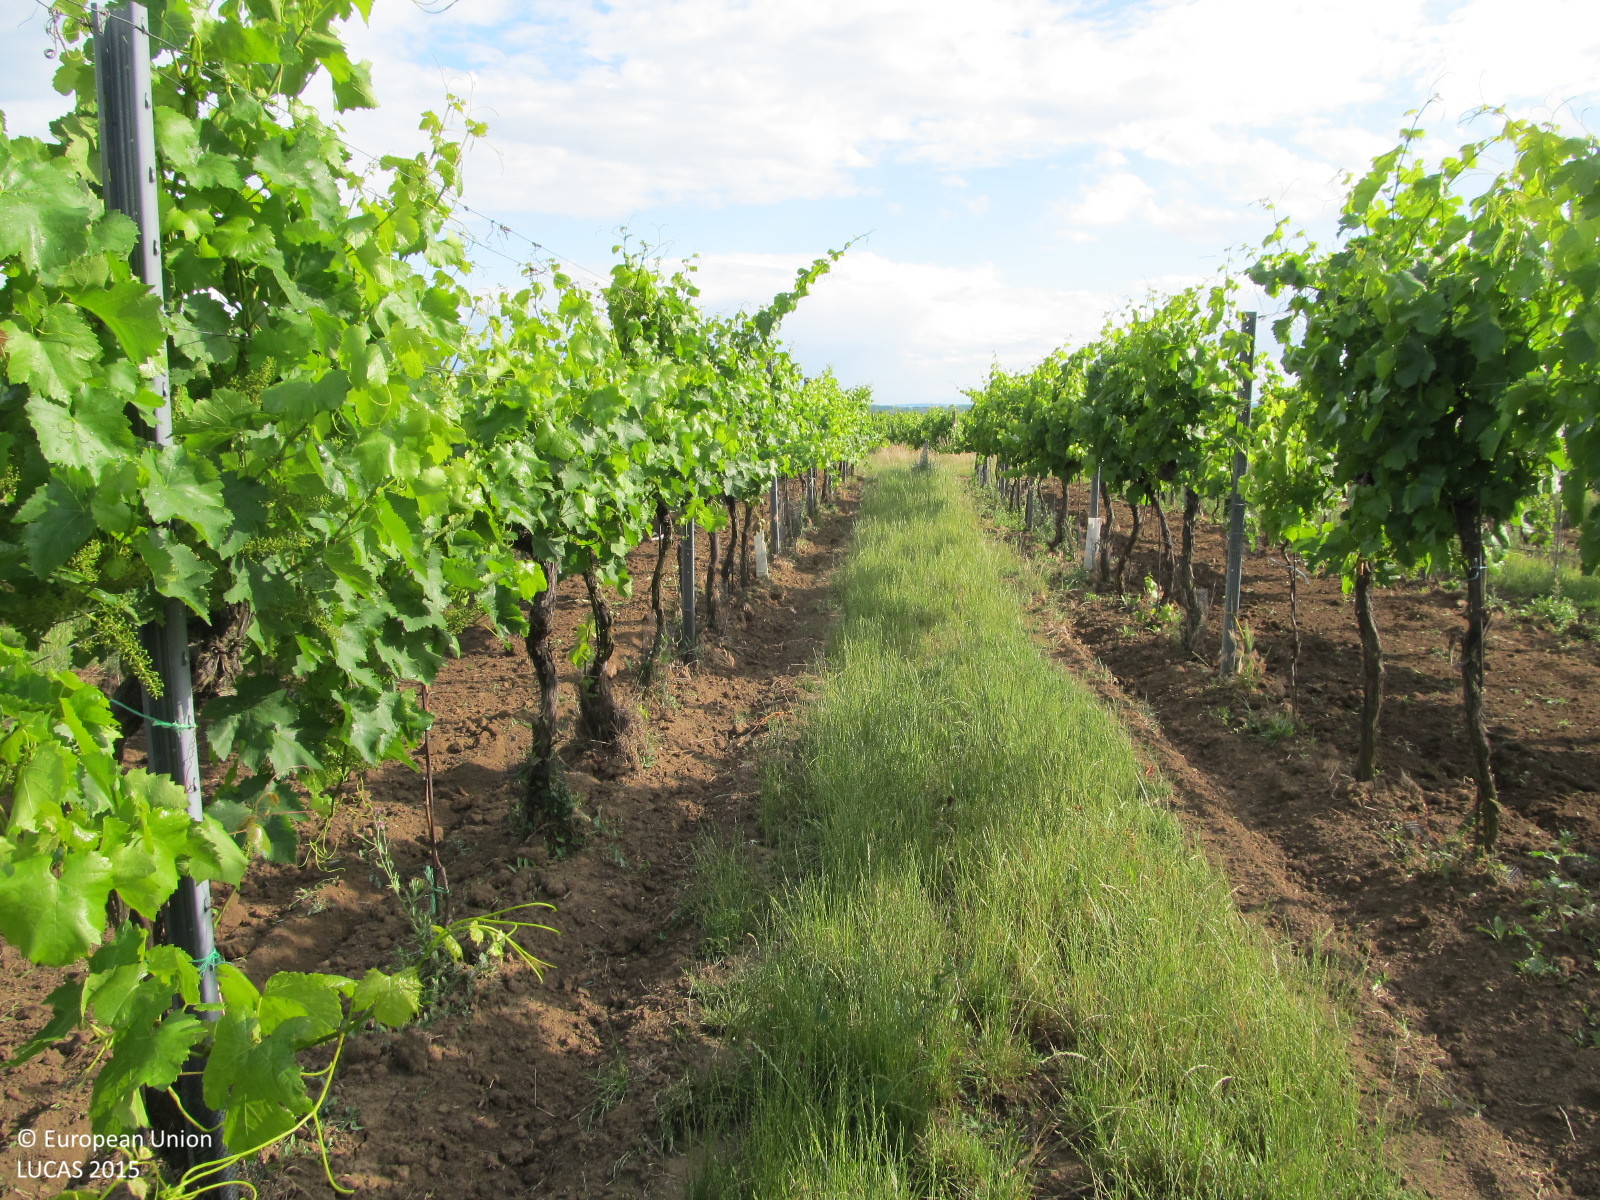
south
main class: Cropland
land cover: Vineyards
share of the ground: 25 - 50 %
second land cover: Grassland without tree/shrub cover
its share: 50 - 75 %
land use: Agriculture (excluding fallow land and kitchen gardens)
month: June
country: AT
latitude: 48.7397
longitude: 16.1104
